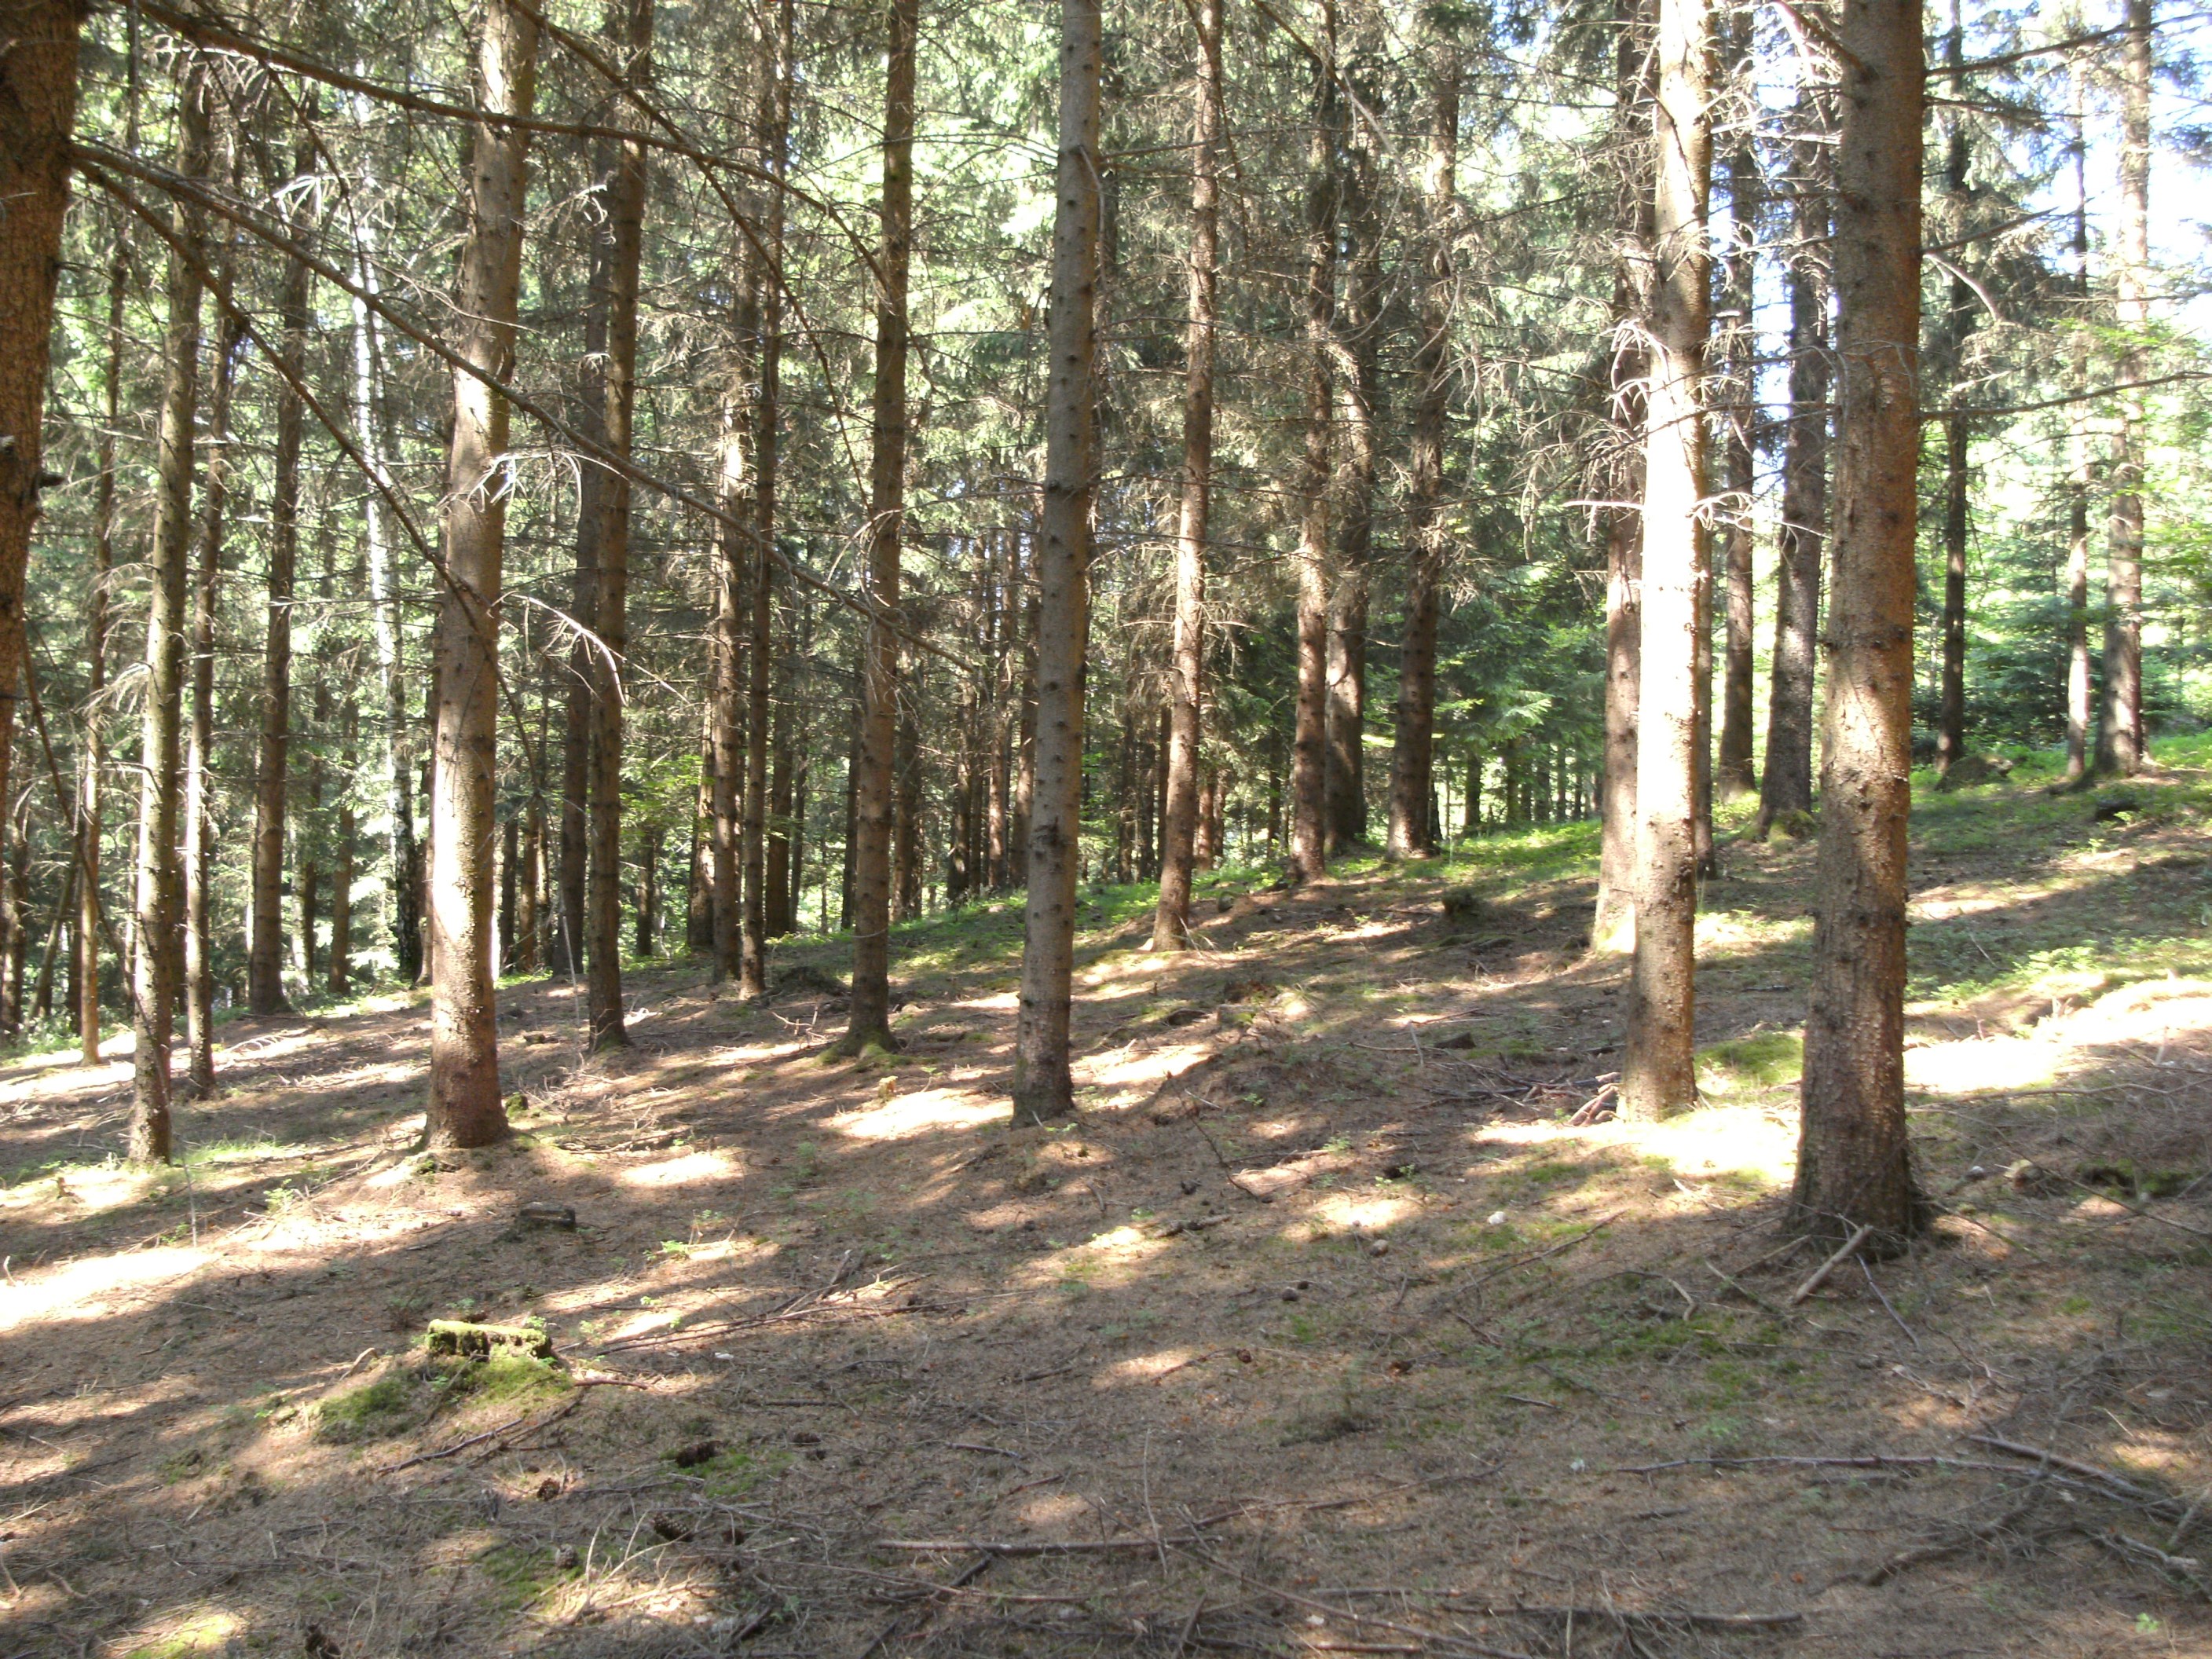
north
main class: Woodland
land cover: Spruce dominated coniferous woodland
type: hemiboreal forest and nemoral coniferous forest and mixed broadleaved-coniferous forest
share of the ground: > 75 %
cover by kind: coniferous forest trees 90 %, unconsolidated bare surface 10 %
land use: Forestry
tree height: > 5 m
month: June
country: AT
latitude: 48.4327
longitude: 14.1765
